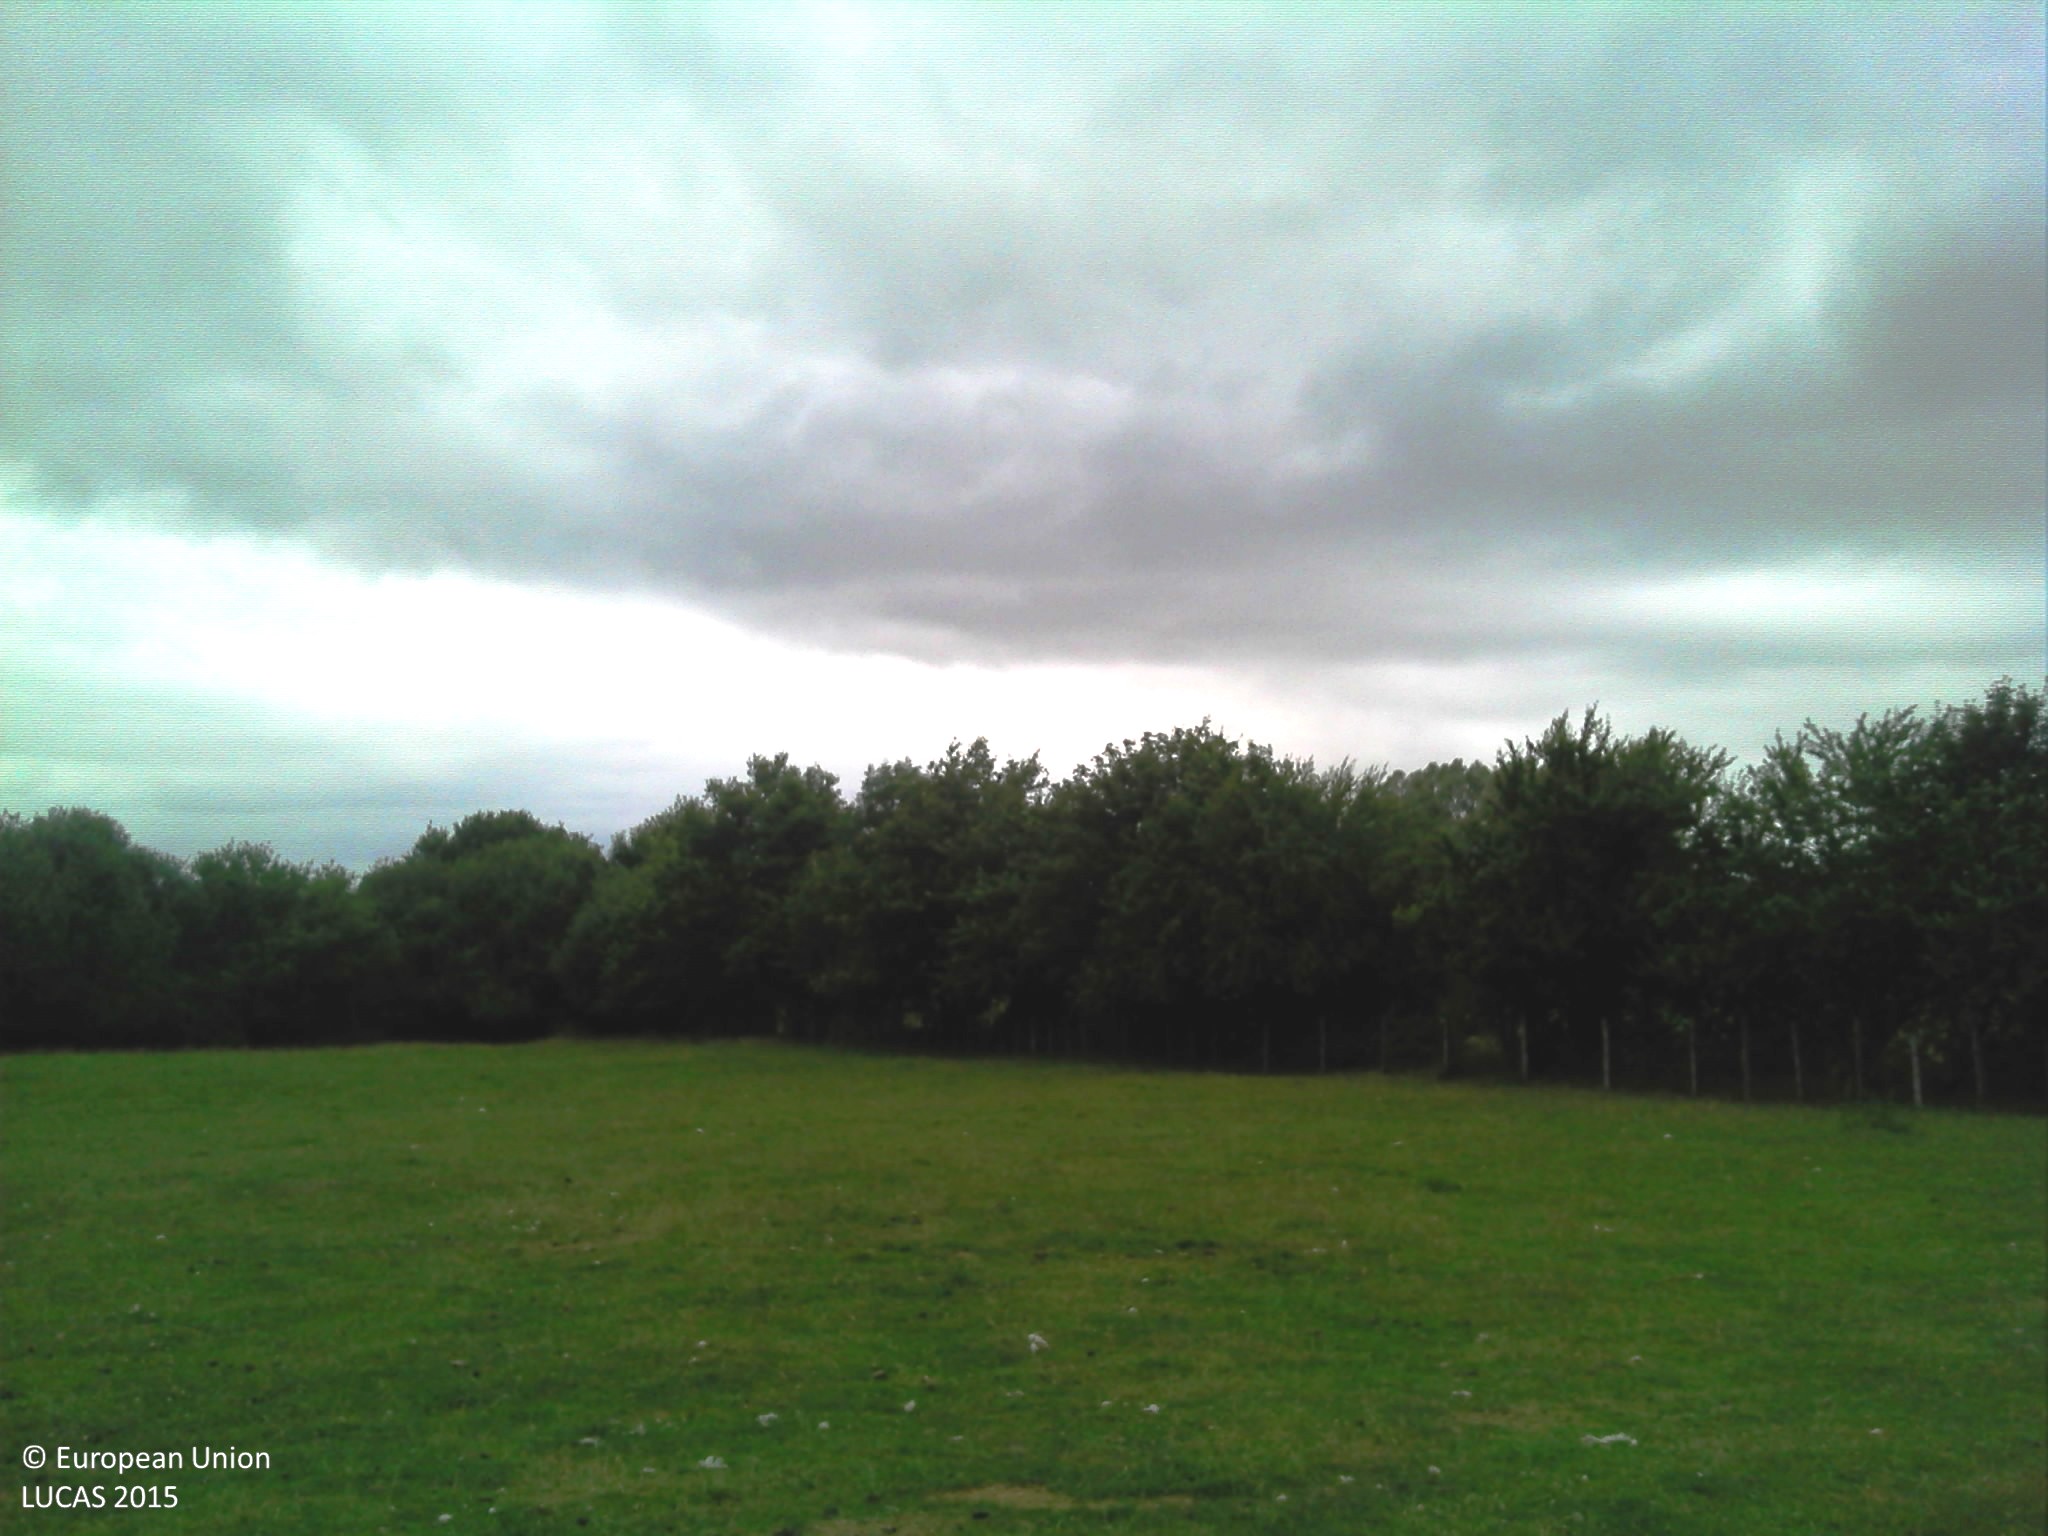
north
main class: Grassland
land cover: Grassland without tree/shrub cover
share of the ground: > 75 %
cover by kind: herbaceous plants 100 %
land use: Agriculture (excluding fallow land and kitchen gardens)
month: June
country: FR
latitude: 48.1129
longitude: 0.2087
